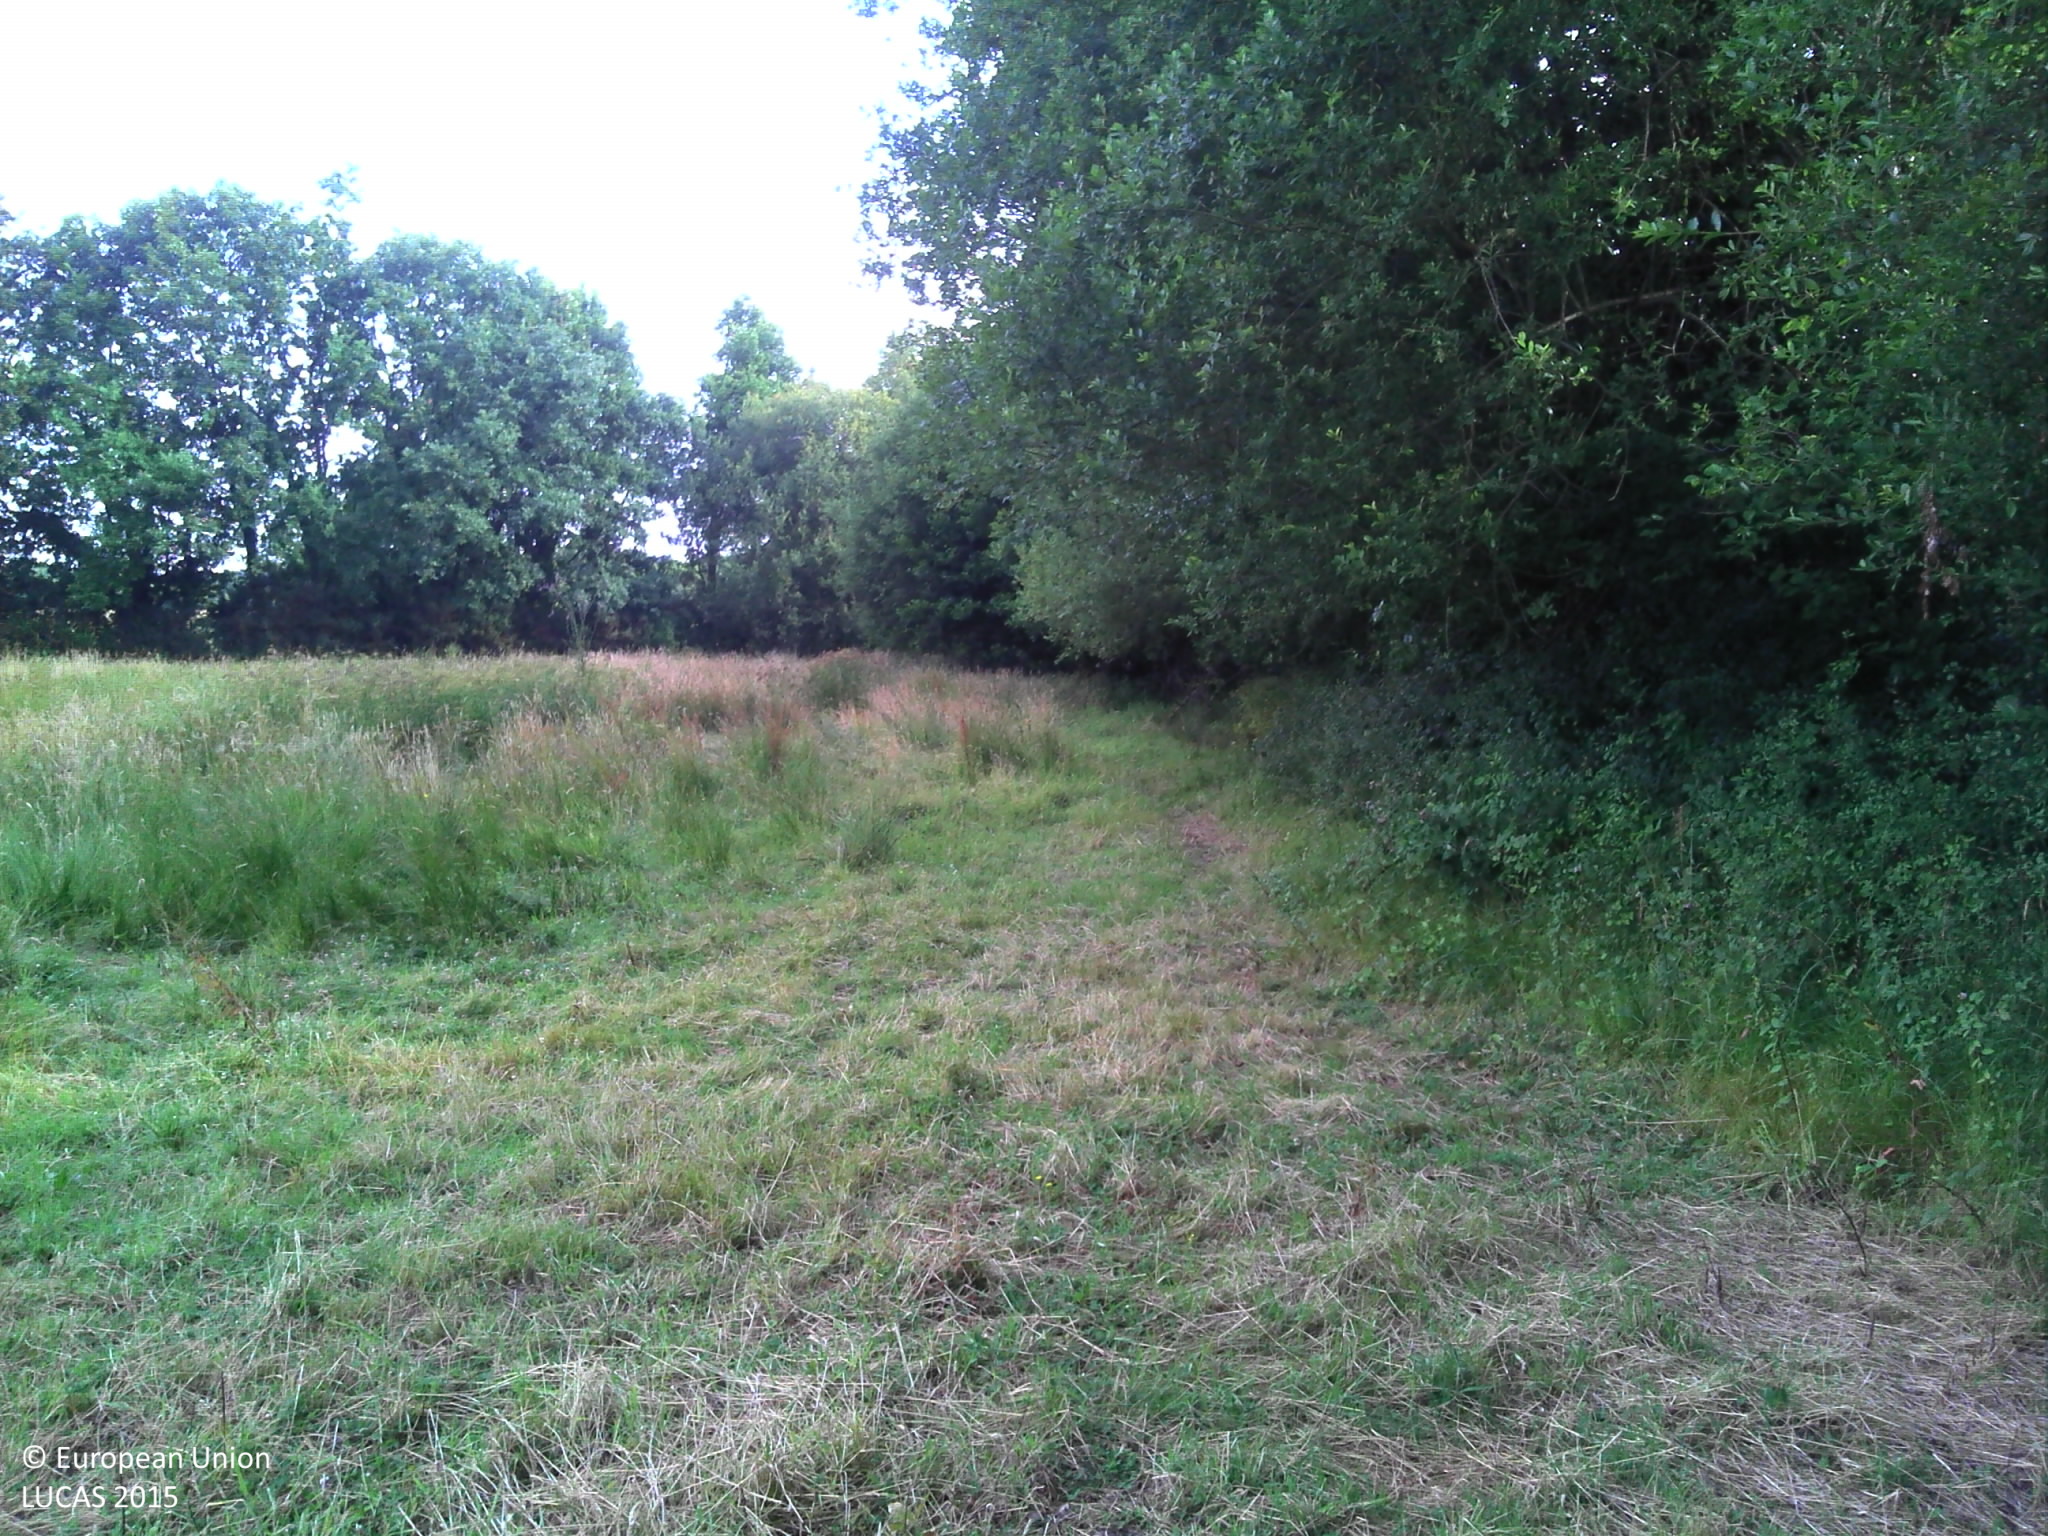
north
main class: Woodland
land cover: Broadleaved woodland
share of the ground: > 75 %
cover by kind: broadleaved forest trees 50 %, shrubs 40 %, herbaceous plants 10 %
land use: Agriculture (excluding fallow land and kitchen gardens)
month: June
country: FR
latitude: 47.3216
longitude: -1.5666
